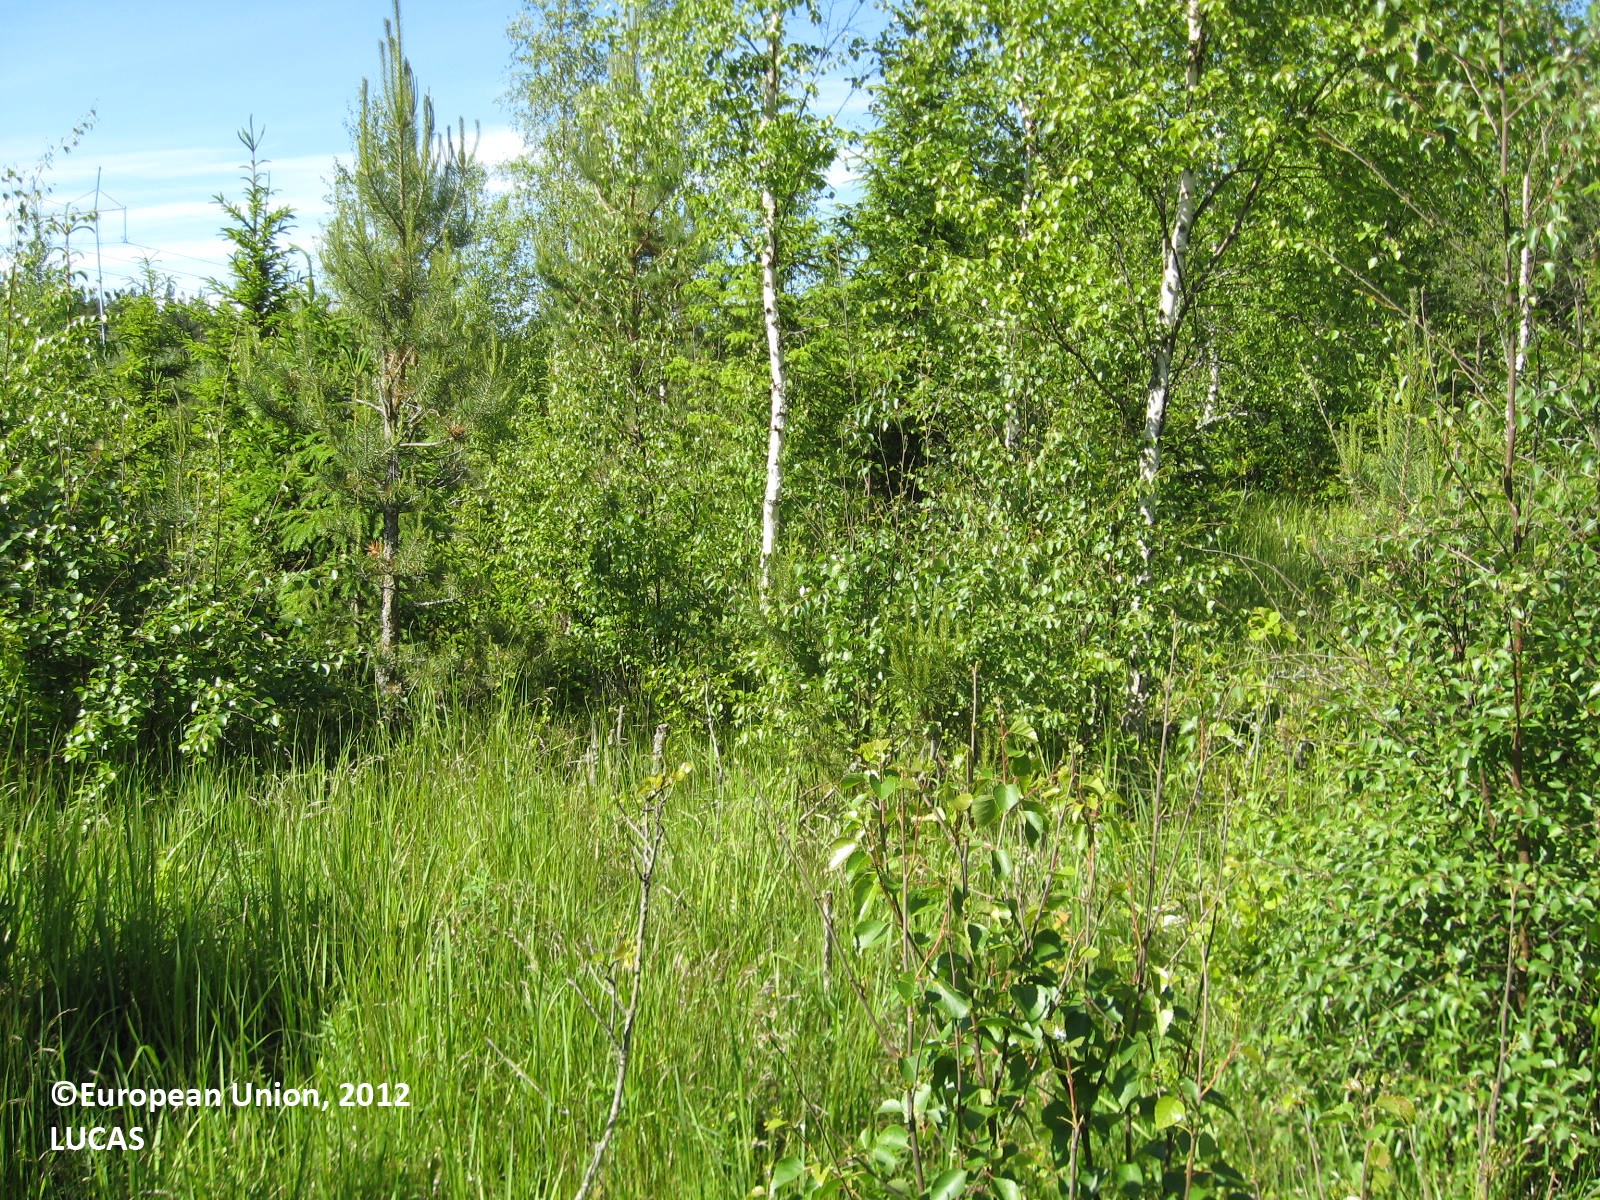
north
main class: Woodland
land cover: Other mixed woodland
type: boreal forest
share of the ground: 50 - 75 %
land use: Forestry
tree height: > 5 m
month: June
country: FI
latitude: 62.8080
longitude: 21.7540
